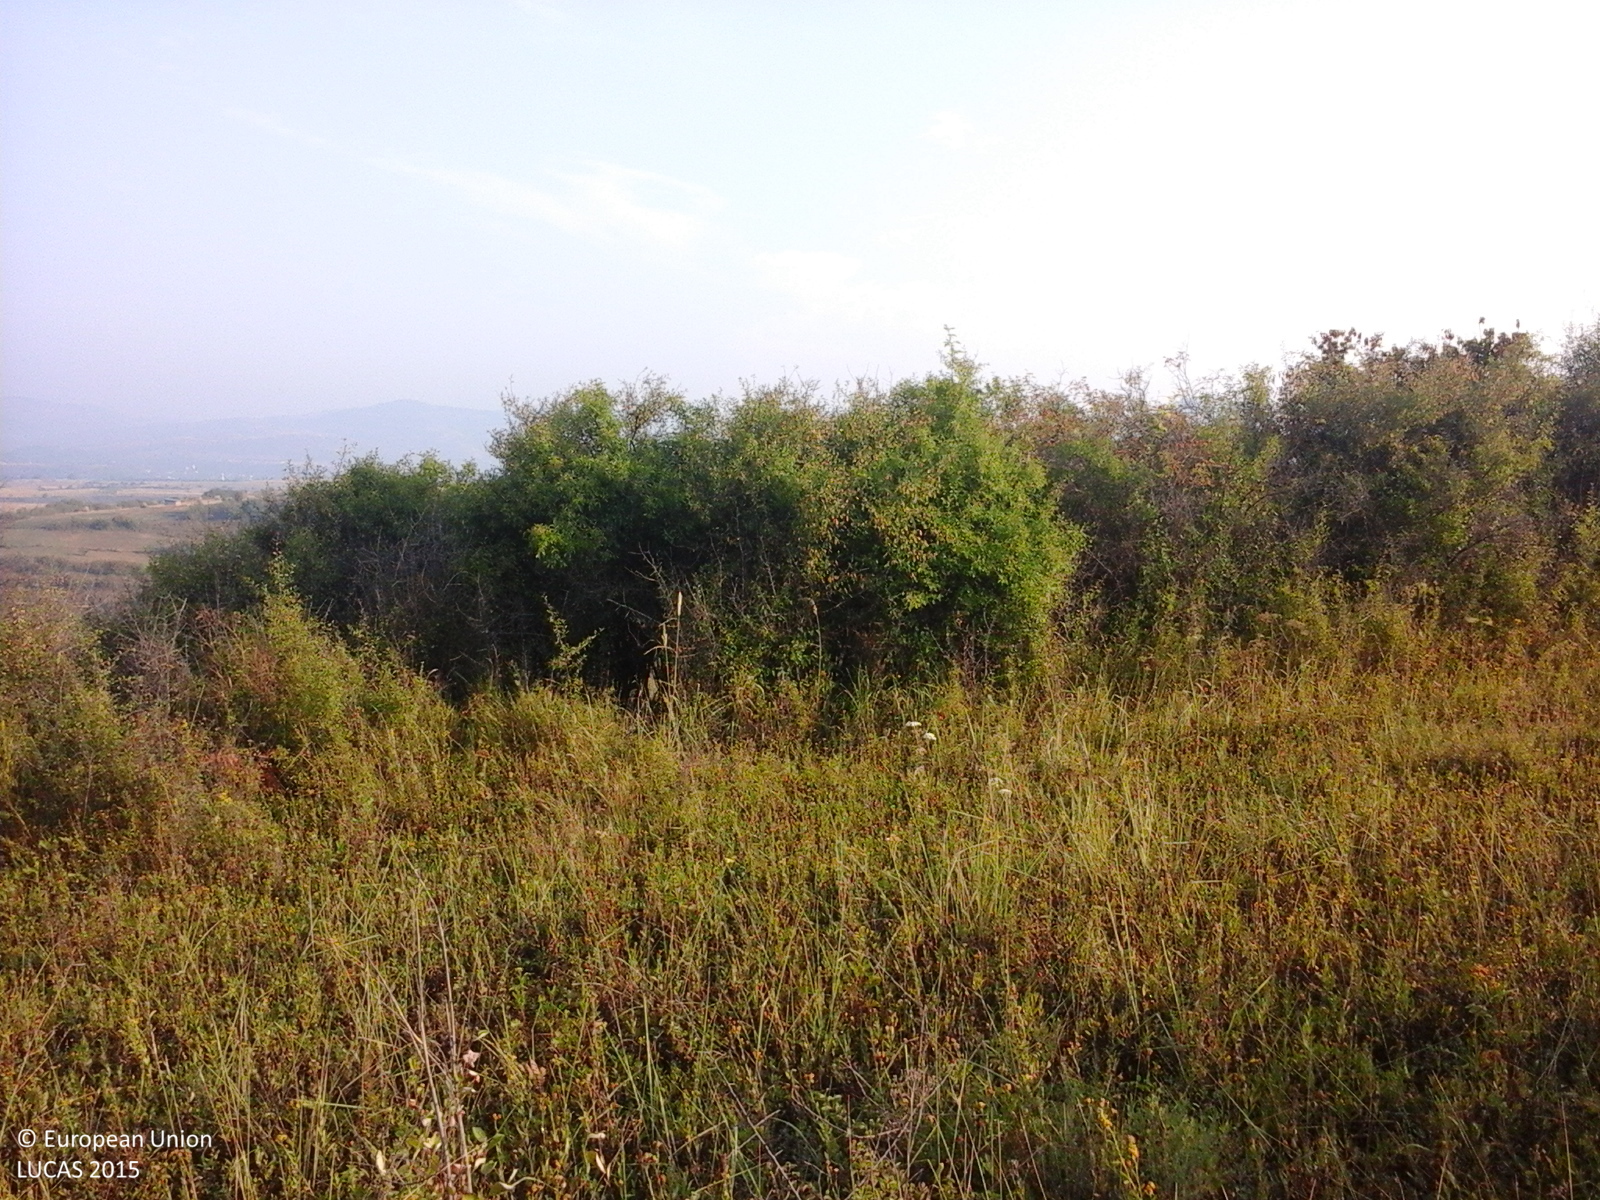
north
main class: Grassland
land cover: Grassland without tree/shrub cover
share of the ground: > 75 %
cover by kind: herbaceous plants 100 %
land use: Agriculture (excluding fallow land and kitchen gardens)
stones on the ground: < 10 %
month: September
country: RO
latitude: 47.2287
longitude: 24.3123
